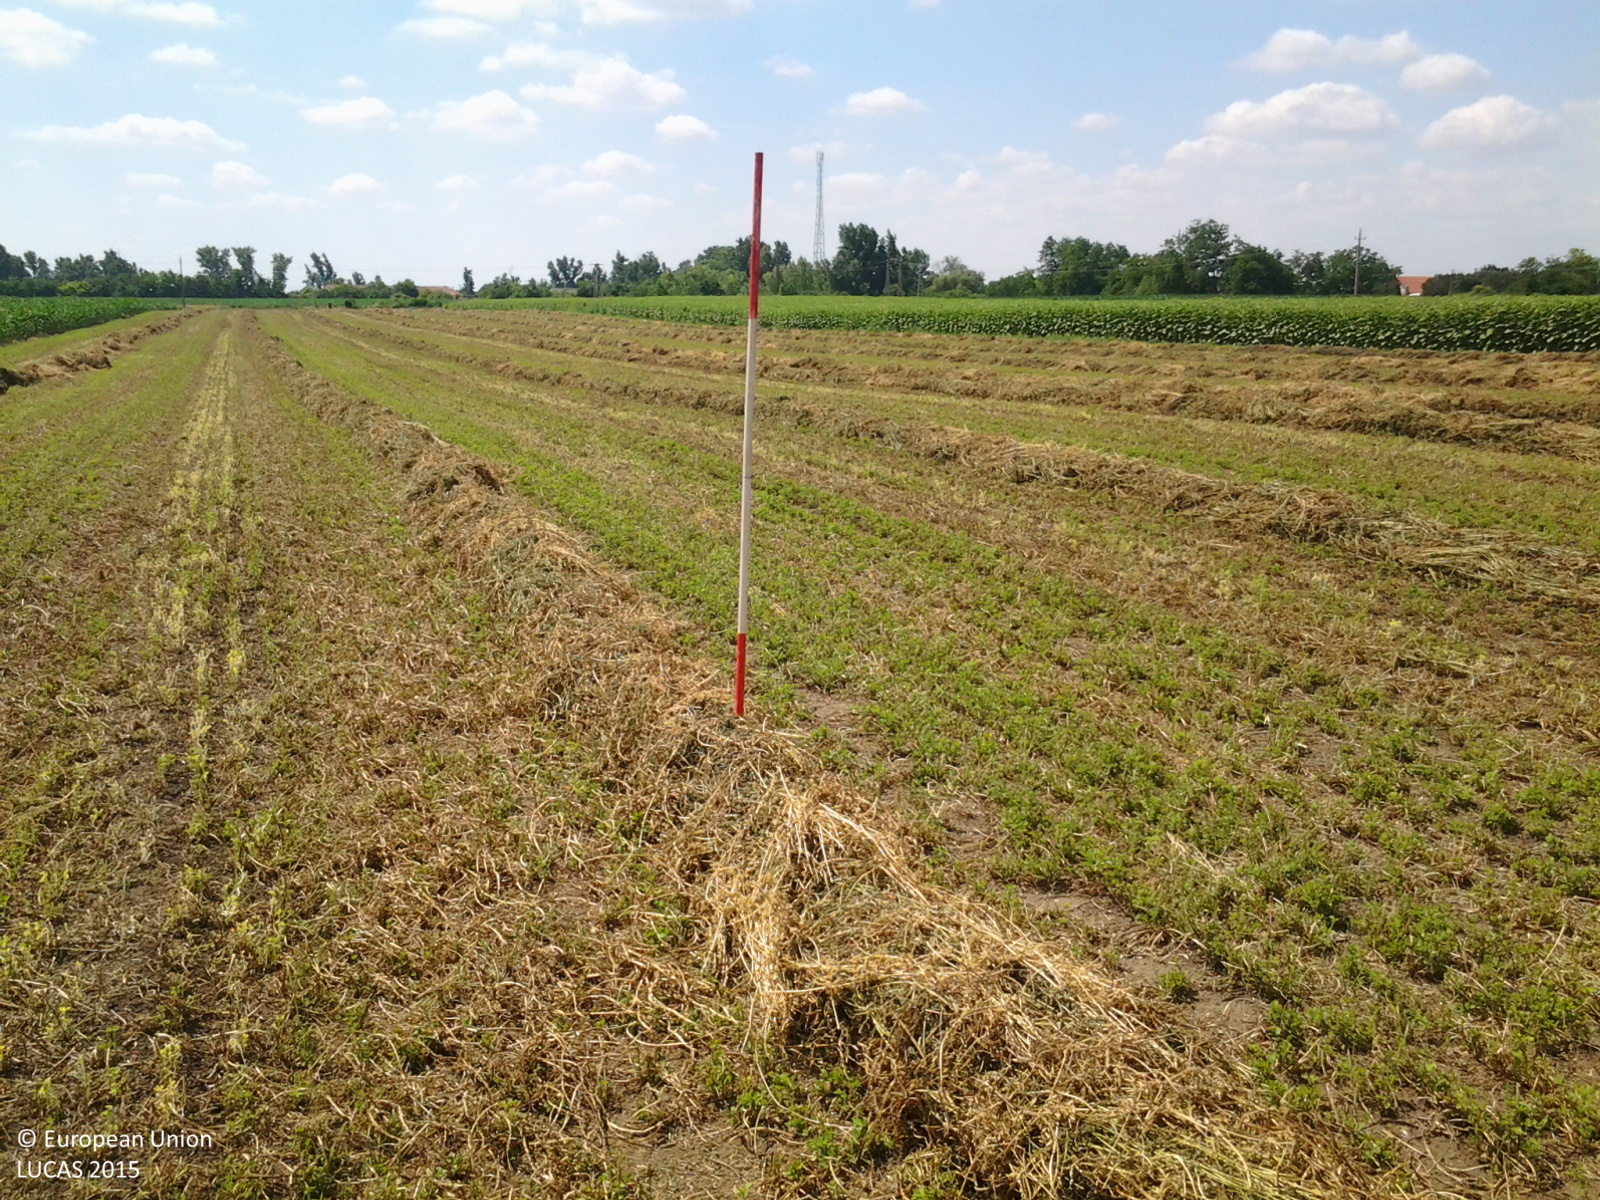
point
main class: Cropland
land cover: Lucerne
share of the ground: 50 - 75 %
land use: Agriculture (excluding fallow land and kitchen gardens)
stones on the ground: < 10 %
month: June
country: HU
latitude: 46.6786
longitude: 20.5781
